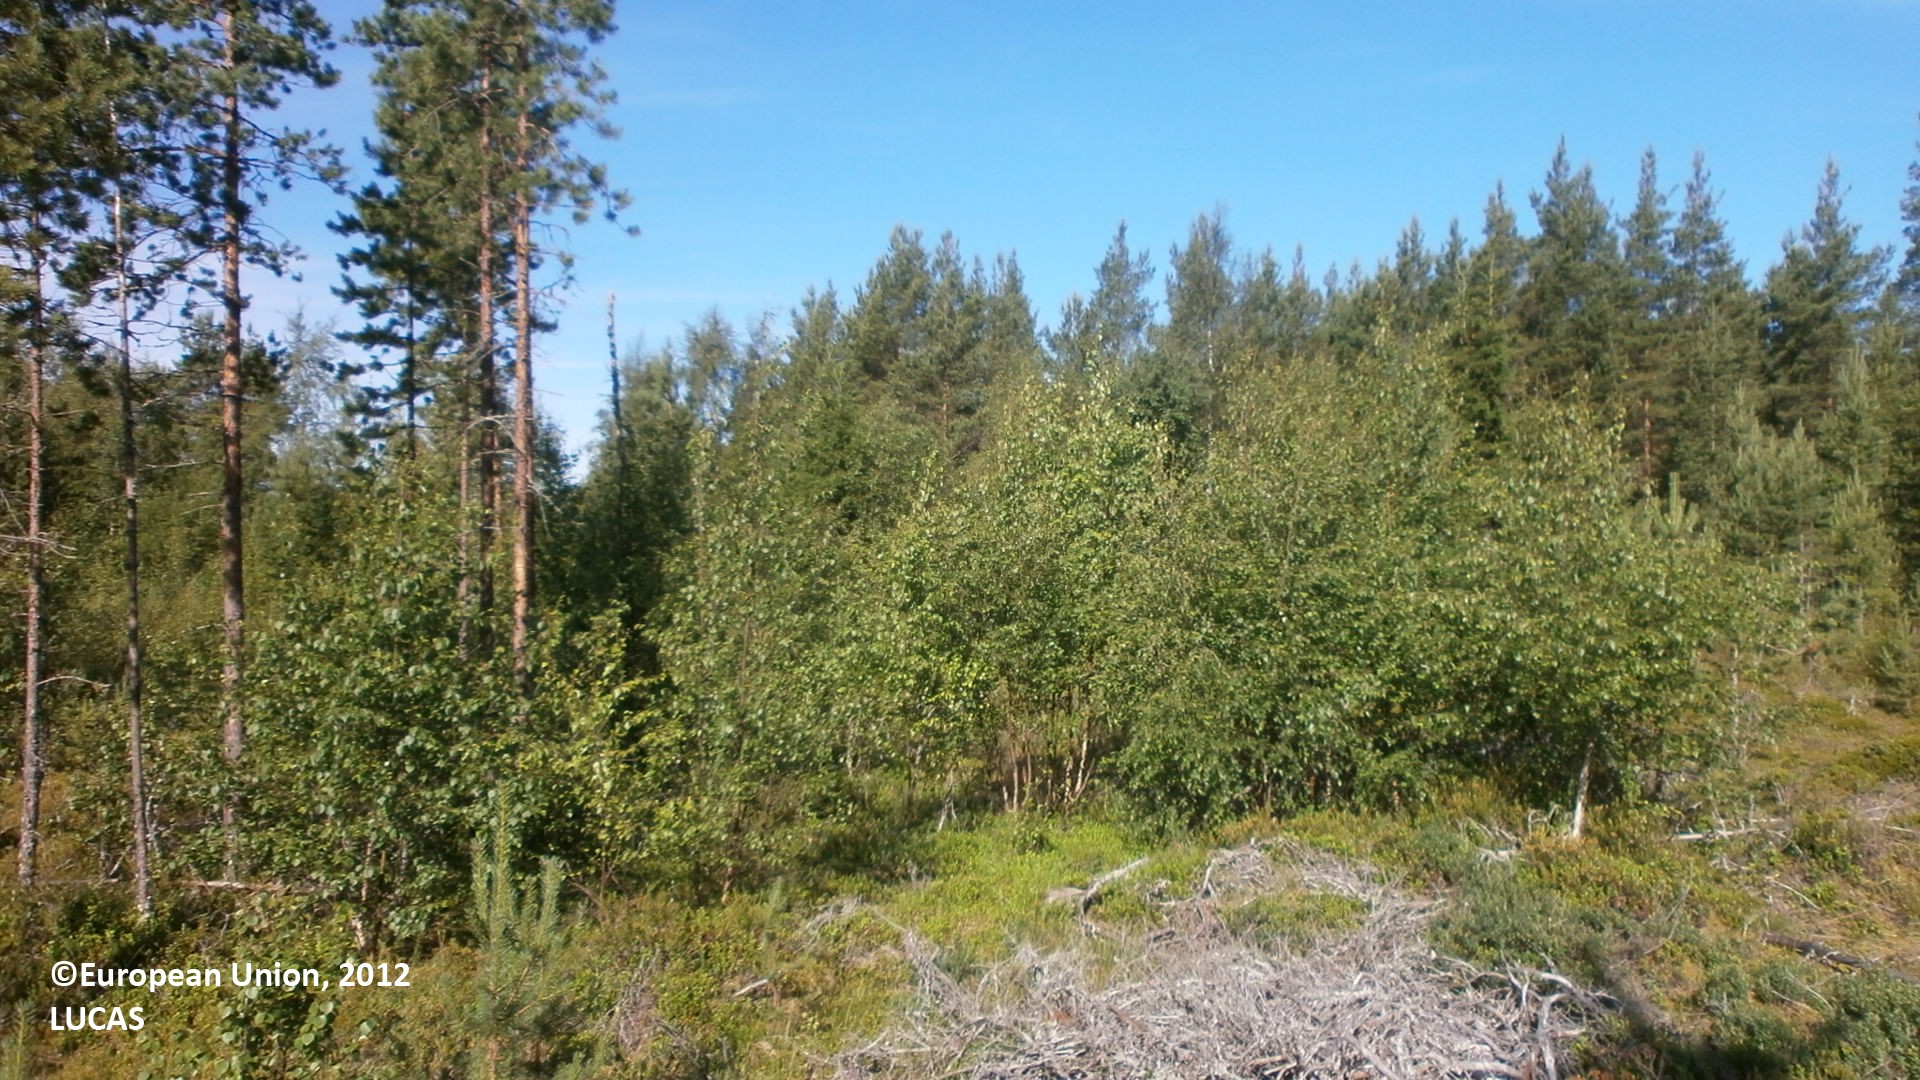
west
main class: Woodland
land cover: Pine dominated mixed woodland
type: boreal forest
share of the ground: 10 - 25 %
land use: Forestry
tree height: > 5 m
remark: Clear cut
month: July
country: FI
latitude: 64.4395
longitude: 24.1683
